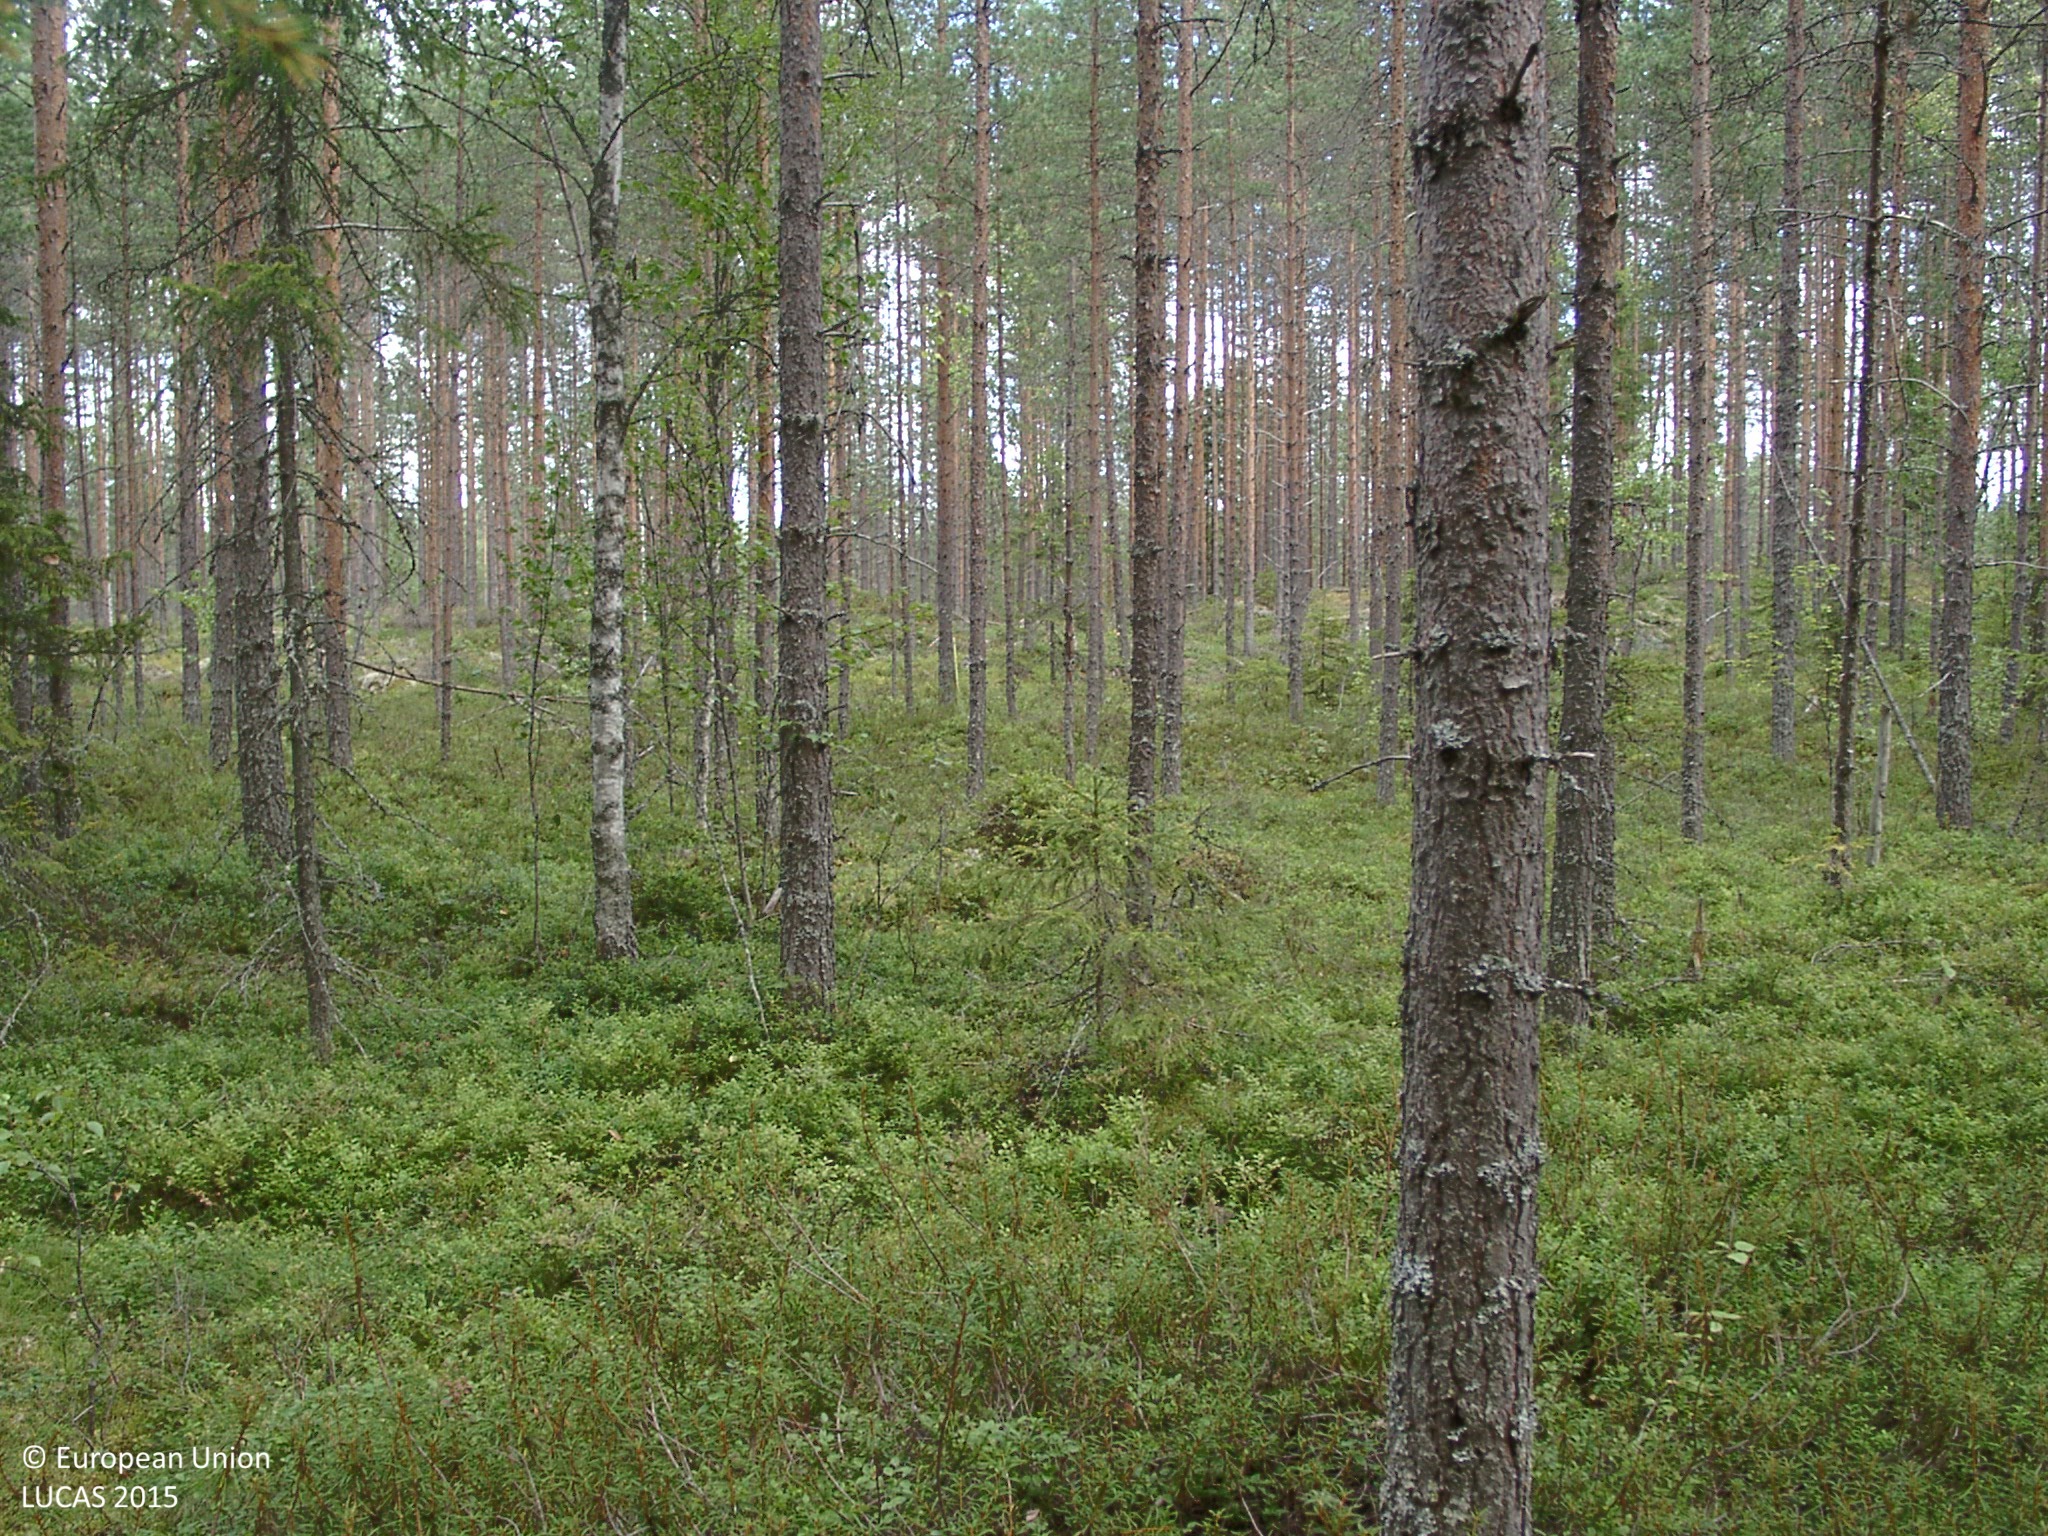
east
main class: Woodland
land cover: Other mixed woodland
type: boreal forest
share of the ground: 50 - 75 %
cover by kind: coniferous forest trees 50 %, broadleaved forest trees 20 %, shrubs 20 %, lichens and mosses 10 %
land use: Forestry
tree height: > 5 m
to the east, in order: Other mixed woodland; Shruby margins; Pine dominated coniferous woodland; Ditches and canals; Shruby margins; Pine dominated coniferous woodland; Ditches and canals; Pine dominated coniferous woodland; Shruby margins; Pine dominated coniferous woodland; Ditches and canals; Pine dominated coniferous woodland
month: August
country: FI
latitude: 62.3935
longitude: 25.4908
